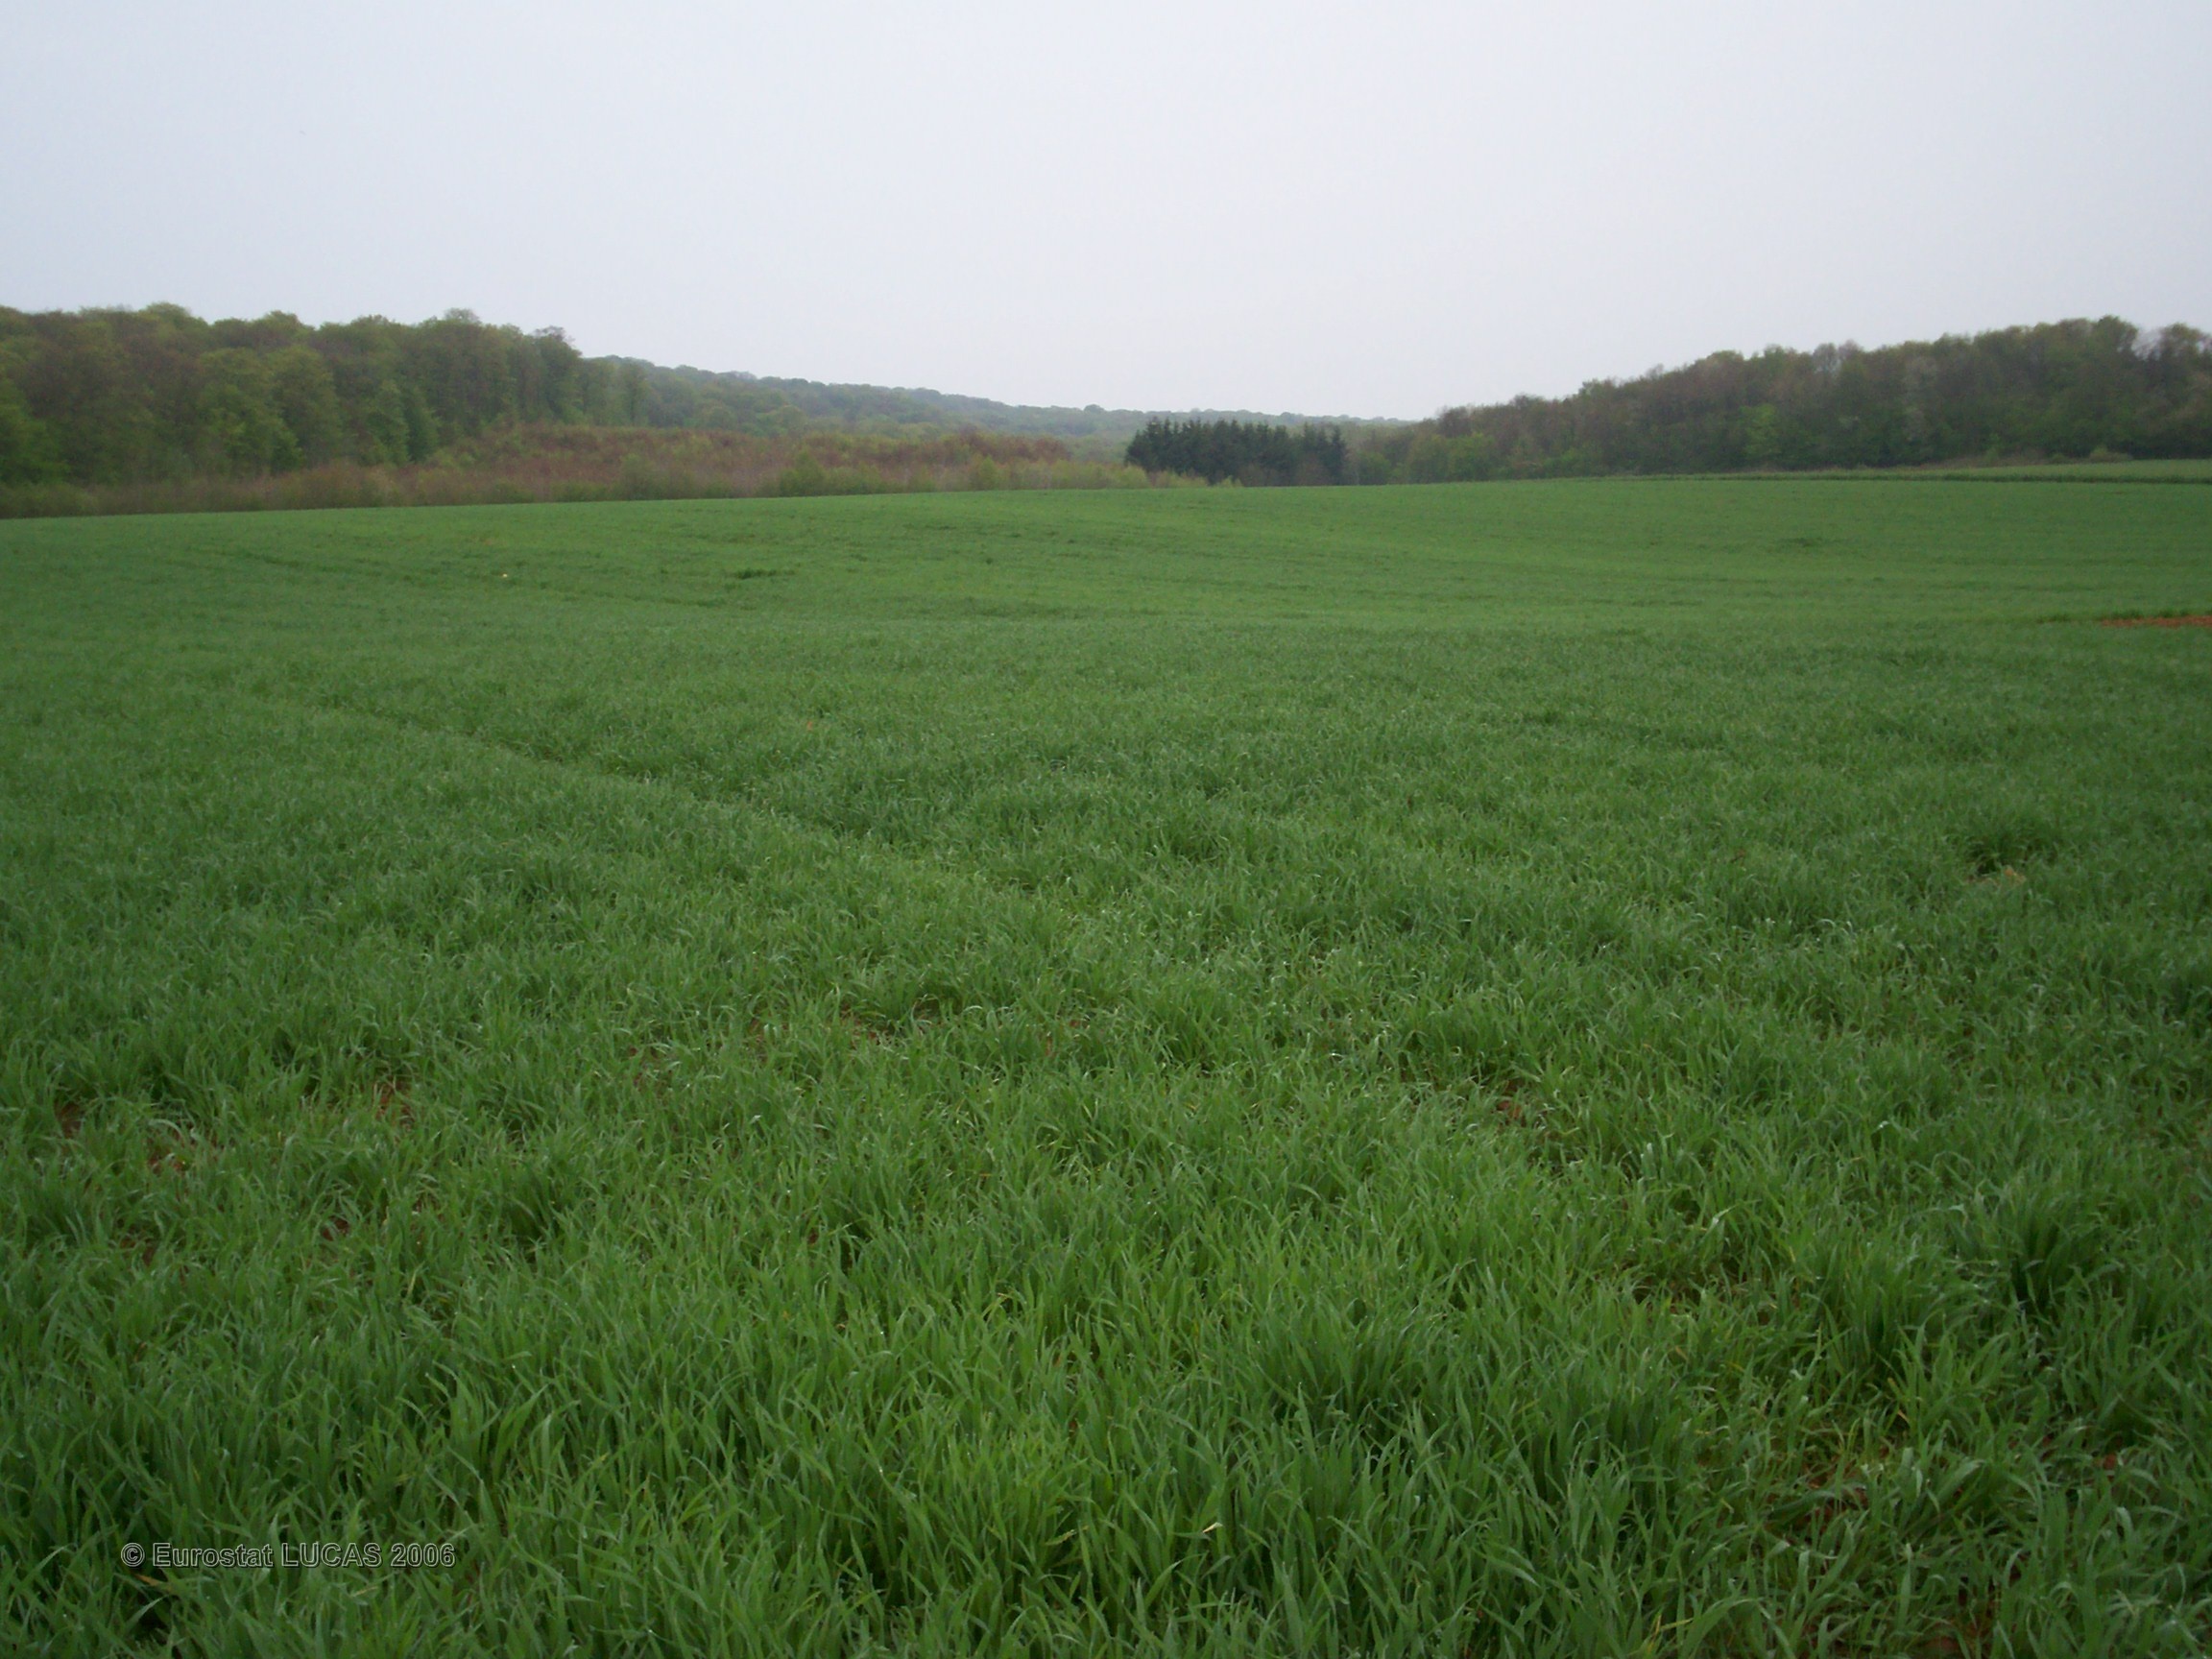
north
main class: Cropland
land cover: Common wheat
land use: Agriculture (excluding fallow land and kitchen gardens)
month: April
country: FR
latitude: 47.5054
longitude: 6.0848
